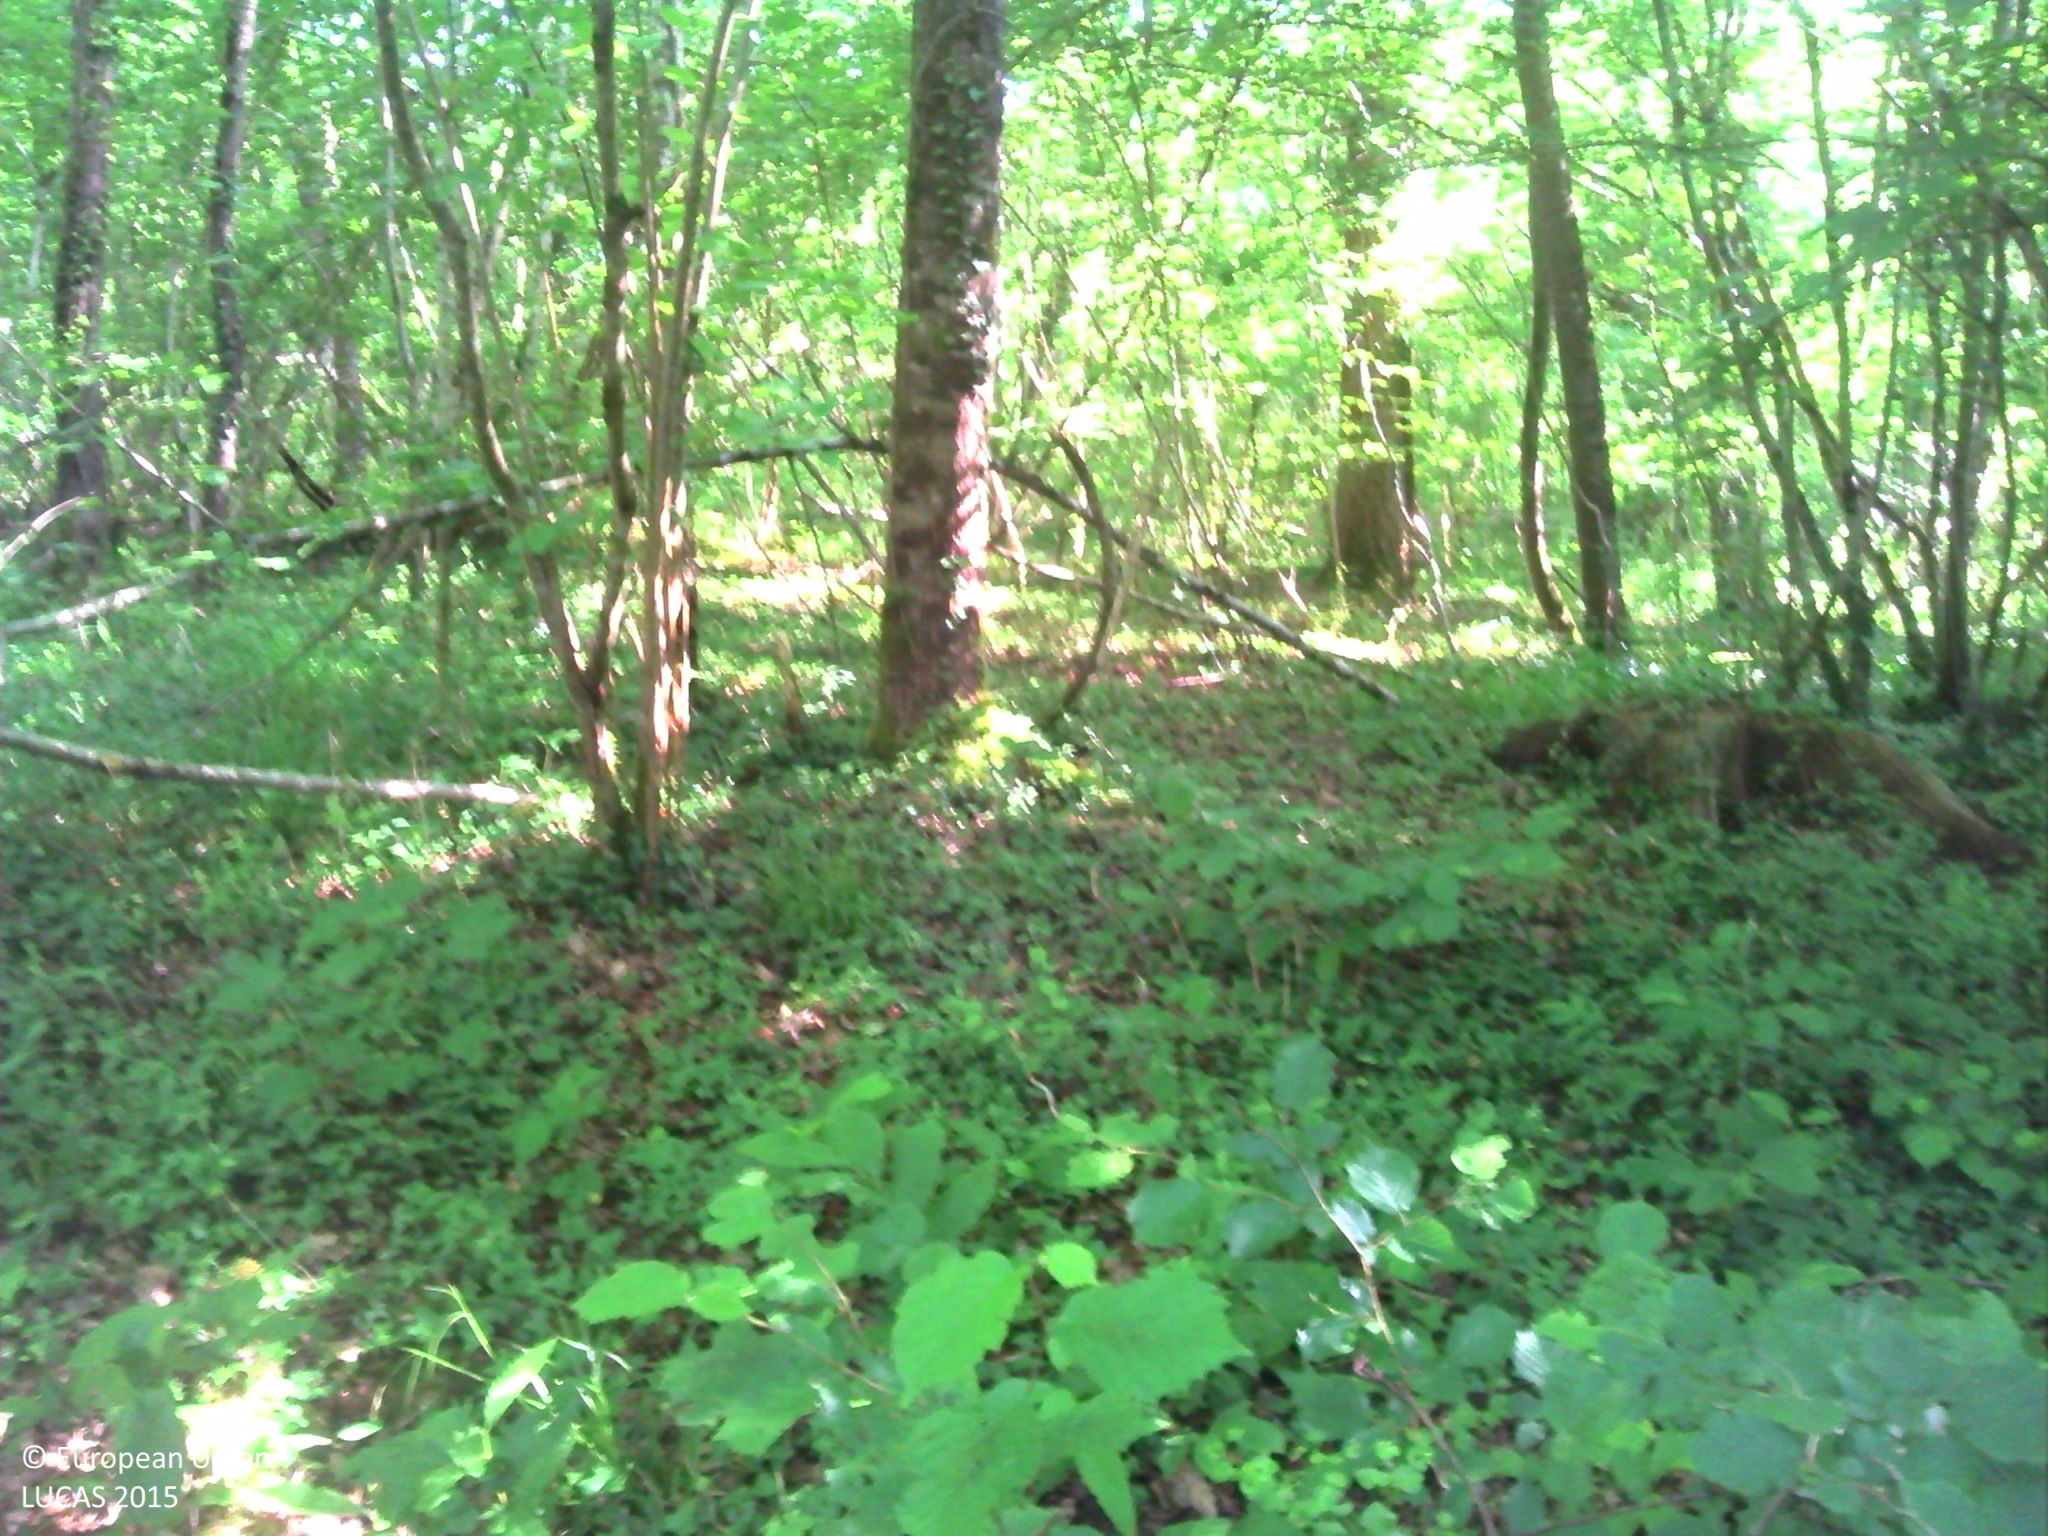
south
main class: Woodland
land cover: Broadleaved woodland
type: mesophytic deciduous forest
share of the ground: > 75 %
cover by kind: broadleaved forest trees 75 %, shrubs 10 %, herbaceous plants 10 %, lichens and mosses 5 %
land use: Forestry
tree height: > 5 m
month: June
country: FR
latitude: 47.5282
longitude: 0.7761
